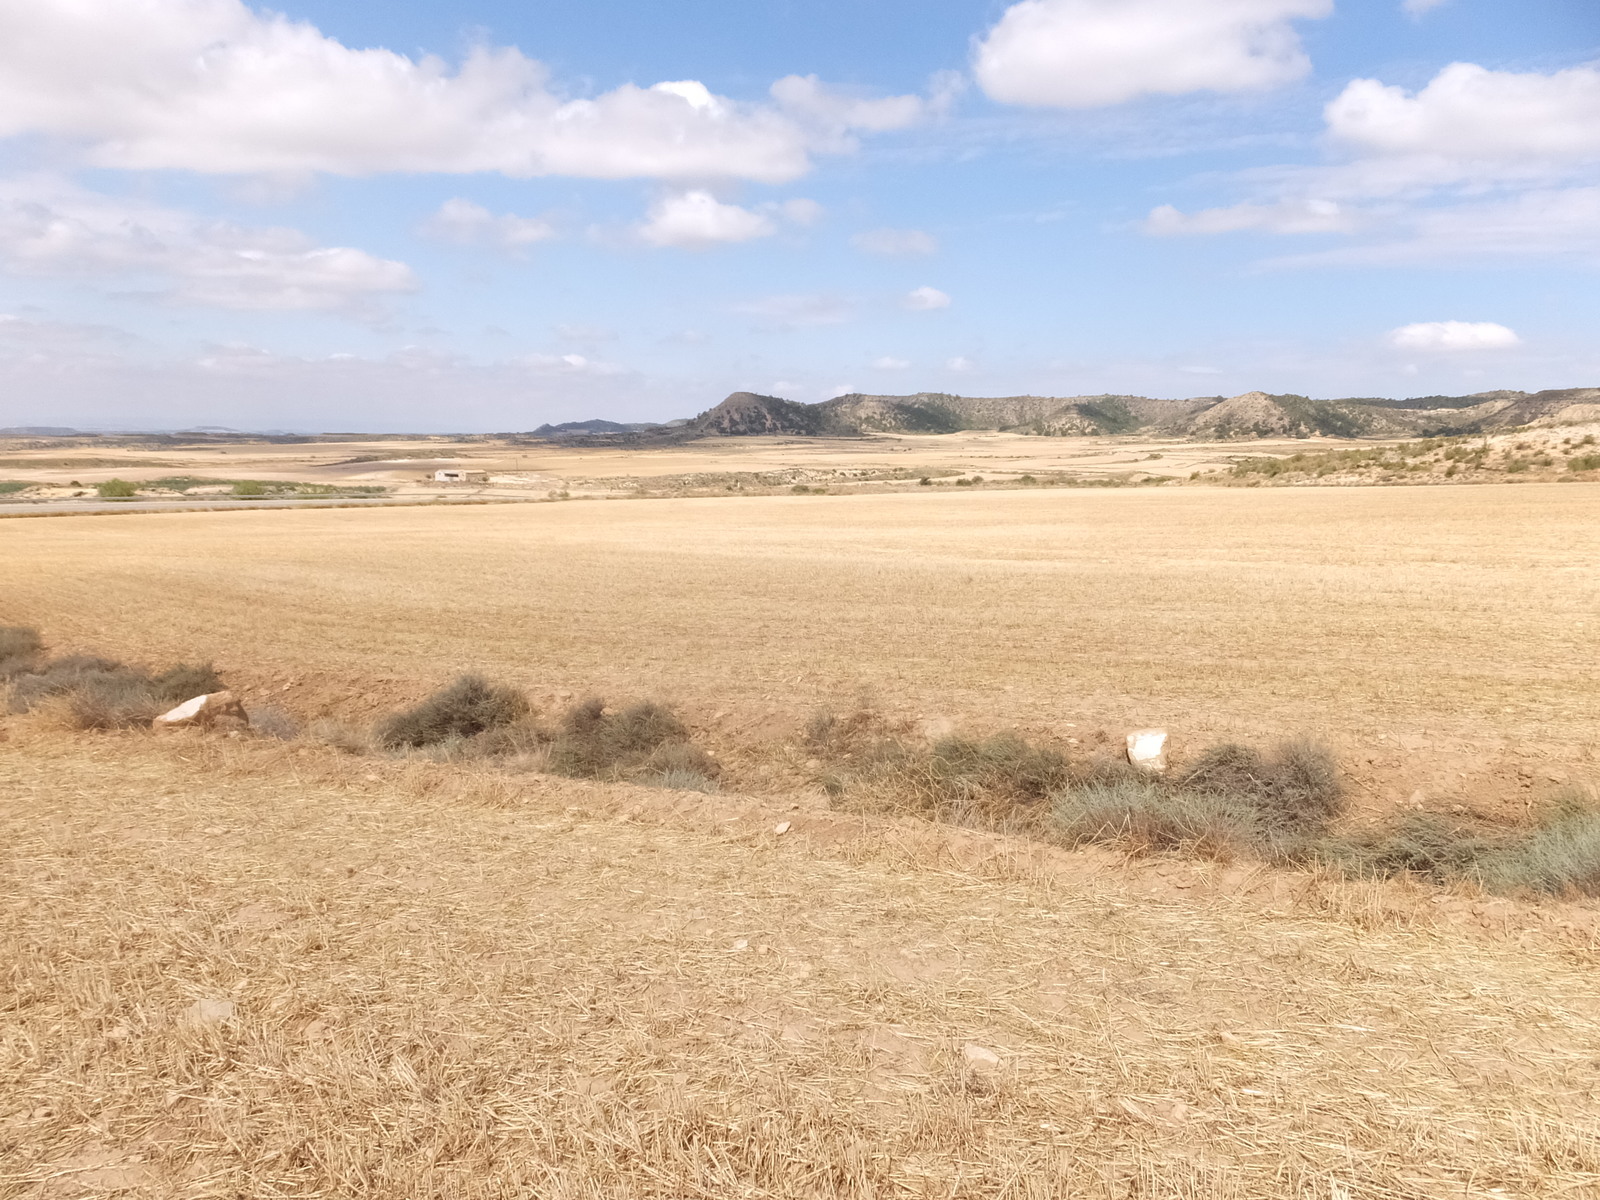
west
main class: Cropland
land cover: Barley
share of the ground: < 10 %
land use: Agriculture (excluding fallow land and kitchen gardens)
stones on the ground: < 10 %
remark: Harvested field
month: June
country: ES
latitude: 41.3306
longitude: -0.0861
